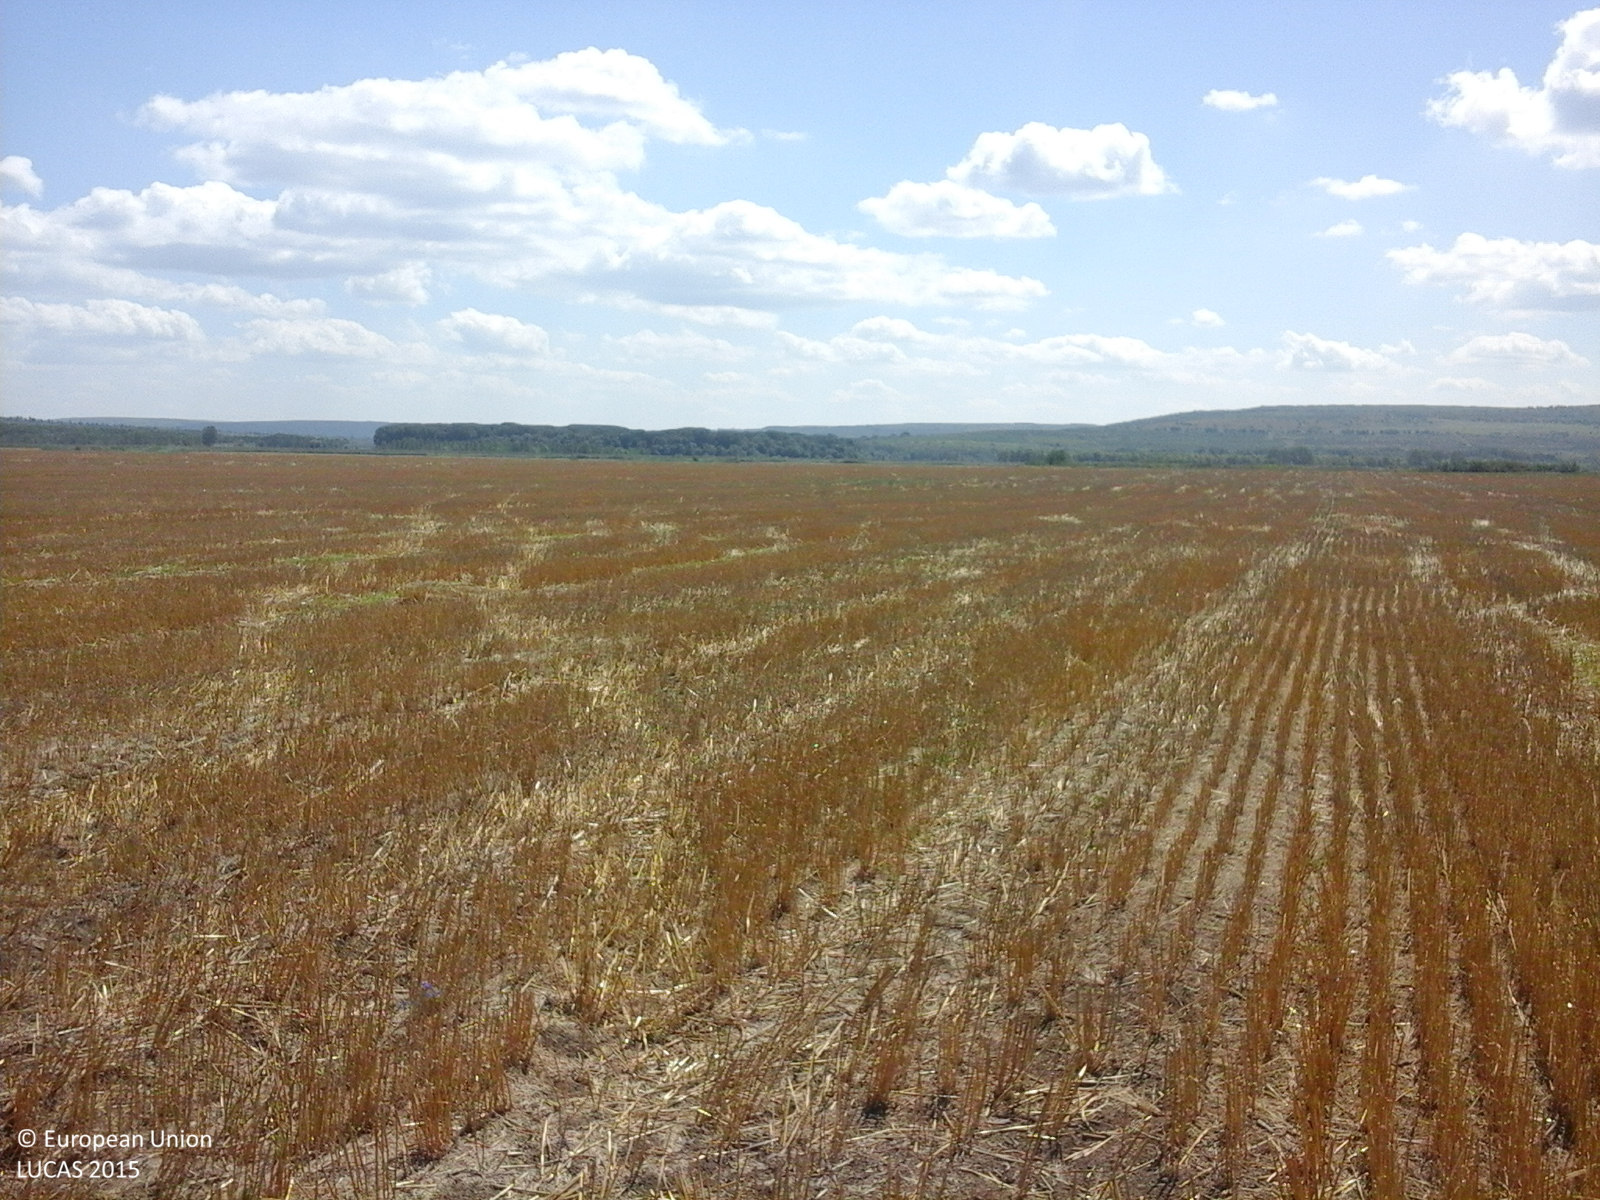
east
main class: Cropland
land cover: Common wheat
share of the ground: 50 - 75 %
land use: Agriculture (excluding fallow land and kitchen gardens)
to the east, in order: Common wheat
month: July
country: RO
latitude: 46.3964
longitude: 28.1968
